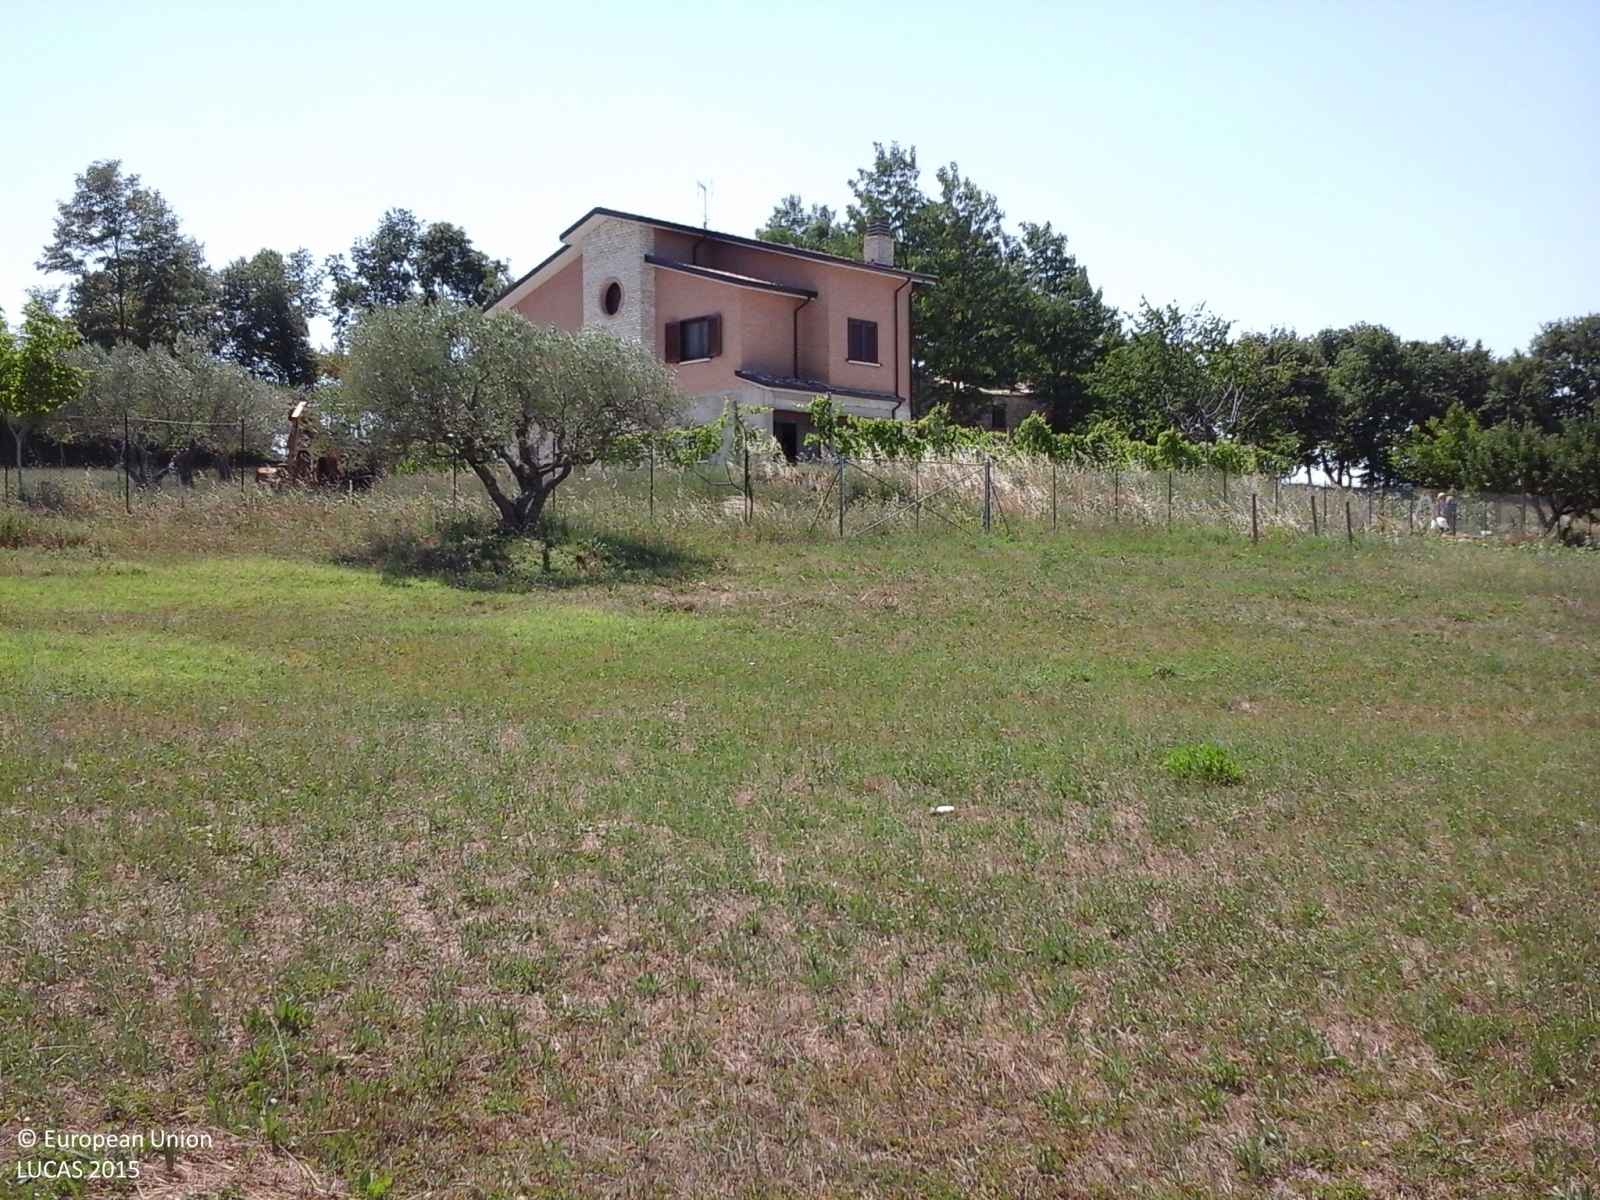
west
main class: Grassland
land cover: Grassland with sparse tree/shrub cover
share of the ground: > 75 %
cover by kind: herbaceous plants 90 %, broadleaved forest trees 5 %, shrubs 5 %
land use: Agriculture (excluding fallow land and kitchen gardens)
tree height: < 5 m
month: July
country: IT
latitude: 41.5656
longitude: 14.7443
